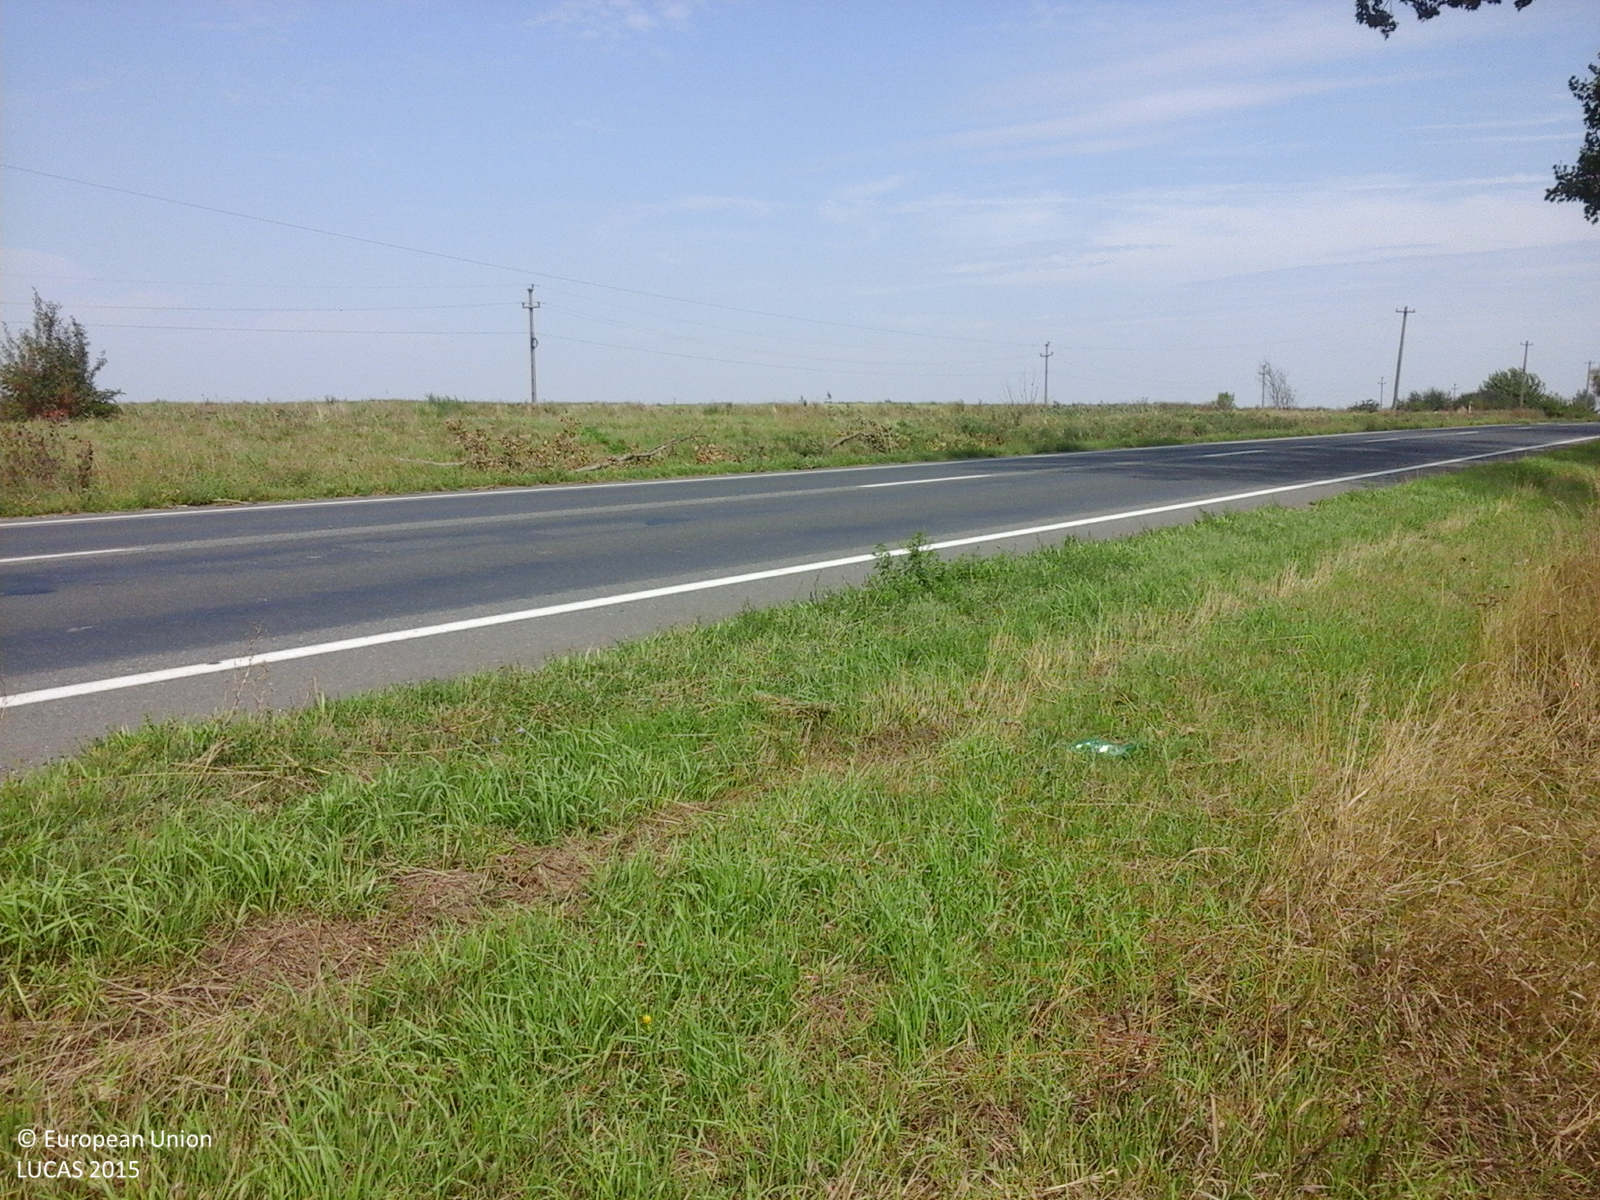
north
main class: Cropland
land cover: Maize
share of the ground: > 75 %
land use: Agriculture (excluding fallow land and kitchen gardens)
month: August
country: RO
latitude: 46.1859
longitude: 21.1350
